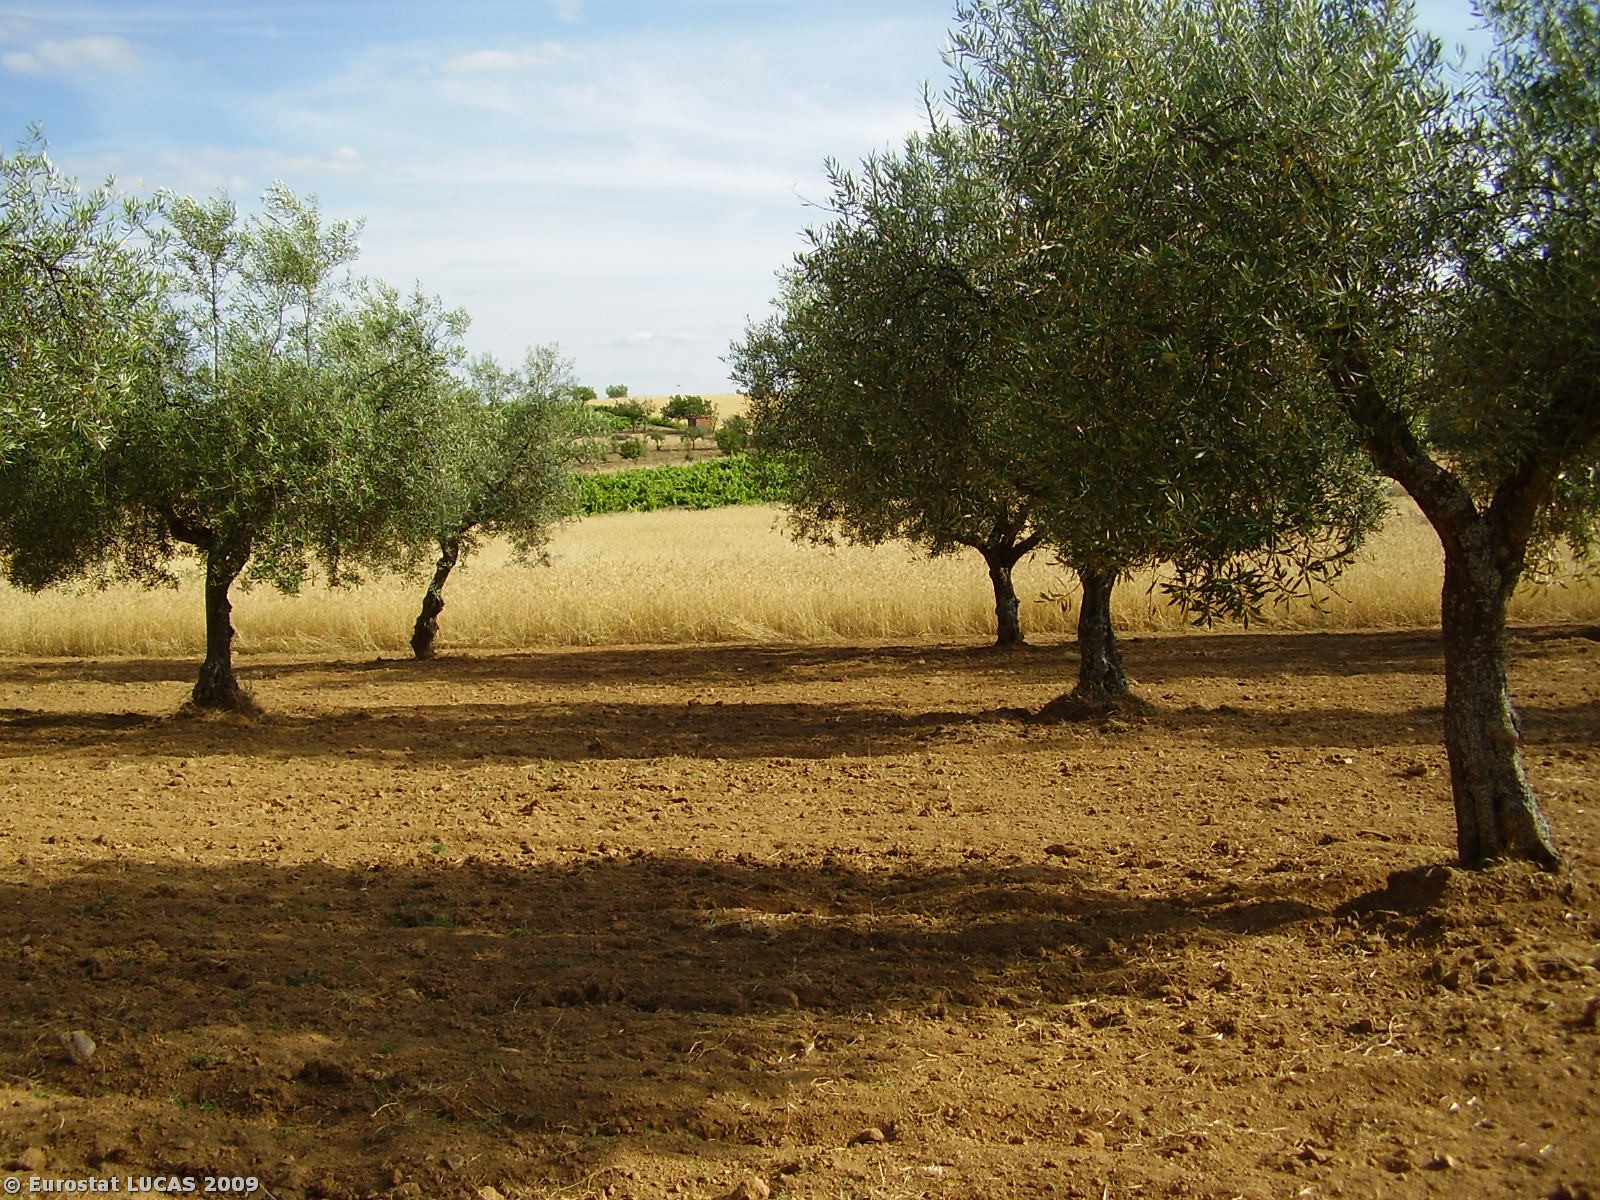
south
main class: Cropland
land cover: Olive groves
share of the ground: 25 - 50 %
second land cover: Bare land
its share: 50 - 75 %
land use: Agriculture (excluding fallow land and kitchen gardens)
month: June
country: PT
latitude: 41.4662
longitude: -6.7631
